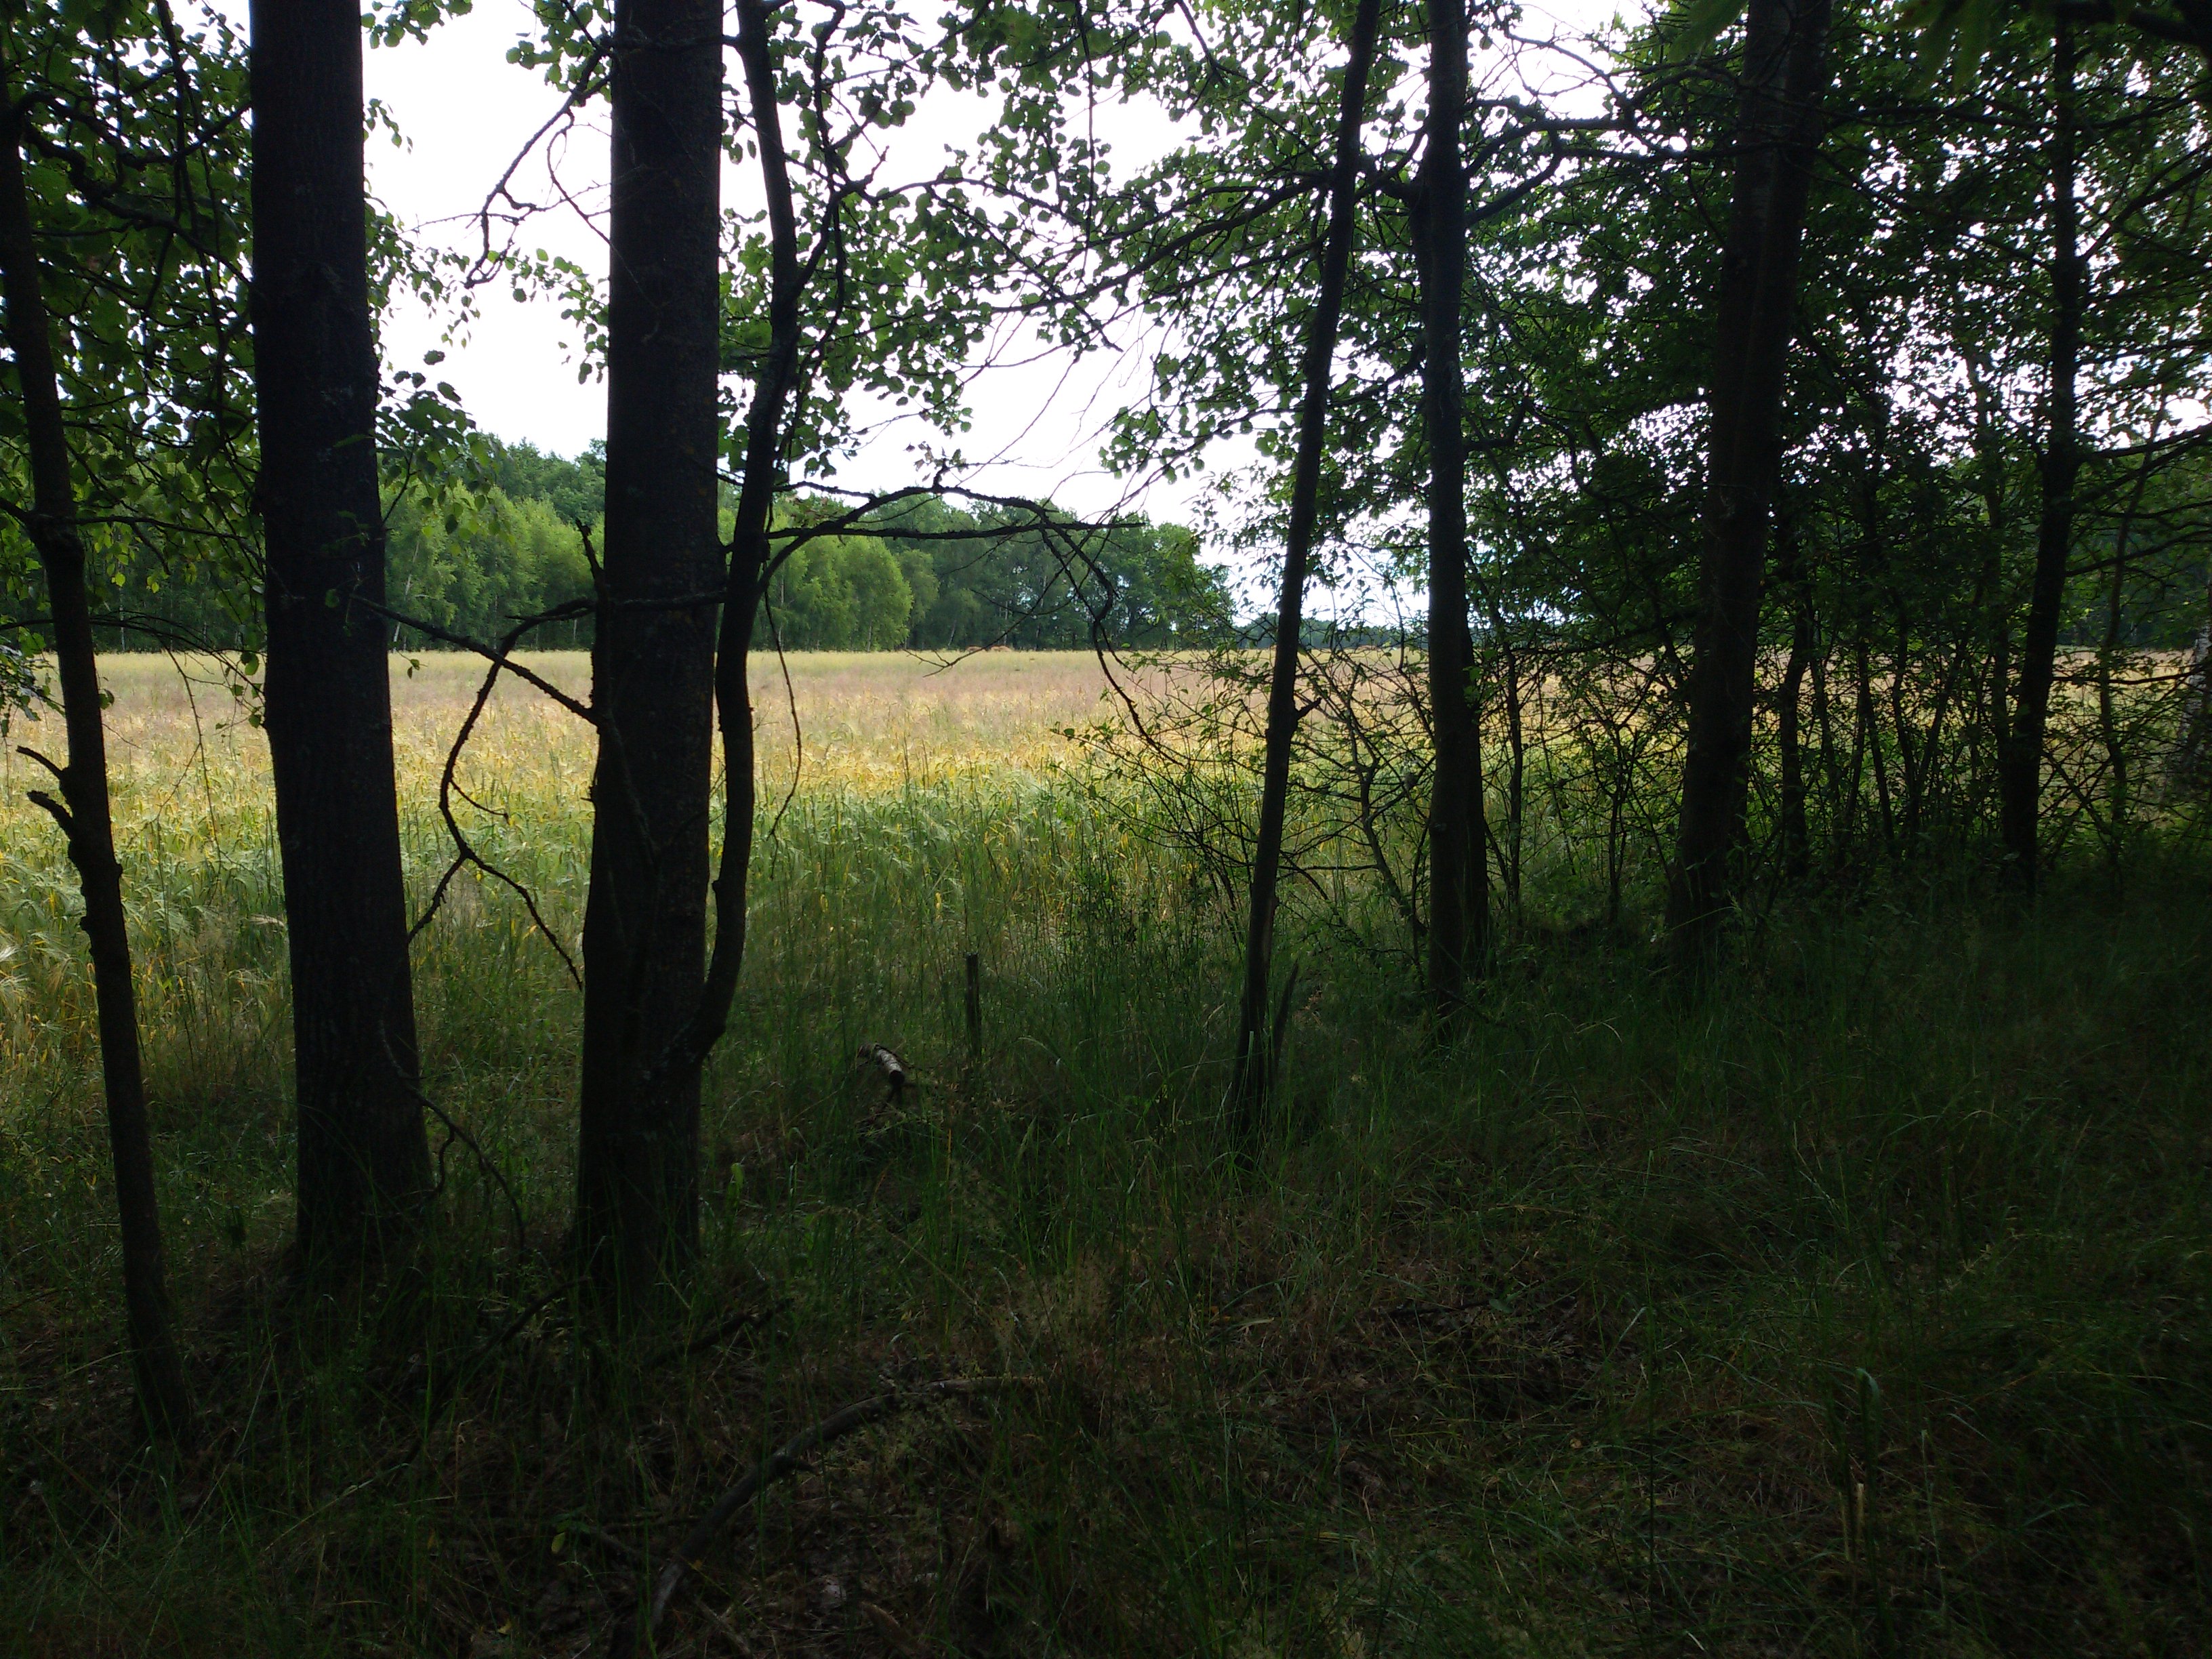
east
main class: Woodland
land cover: Broadleaved woodland
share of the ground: > 75 %
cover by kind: broadleaved forest trees 90 %, herbaceous plants 10 %
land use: Forestry
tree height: > 5 m
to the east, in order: Broadleaved woodland; Barley; Common wheat; Rape and turnip rape; Spontaneously vegetated surfaces; Tracks; Oats
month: June
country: PL
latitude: 51.7631
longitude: 23.0438
